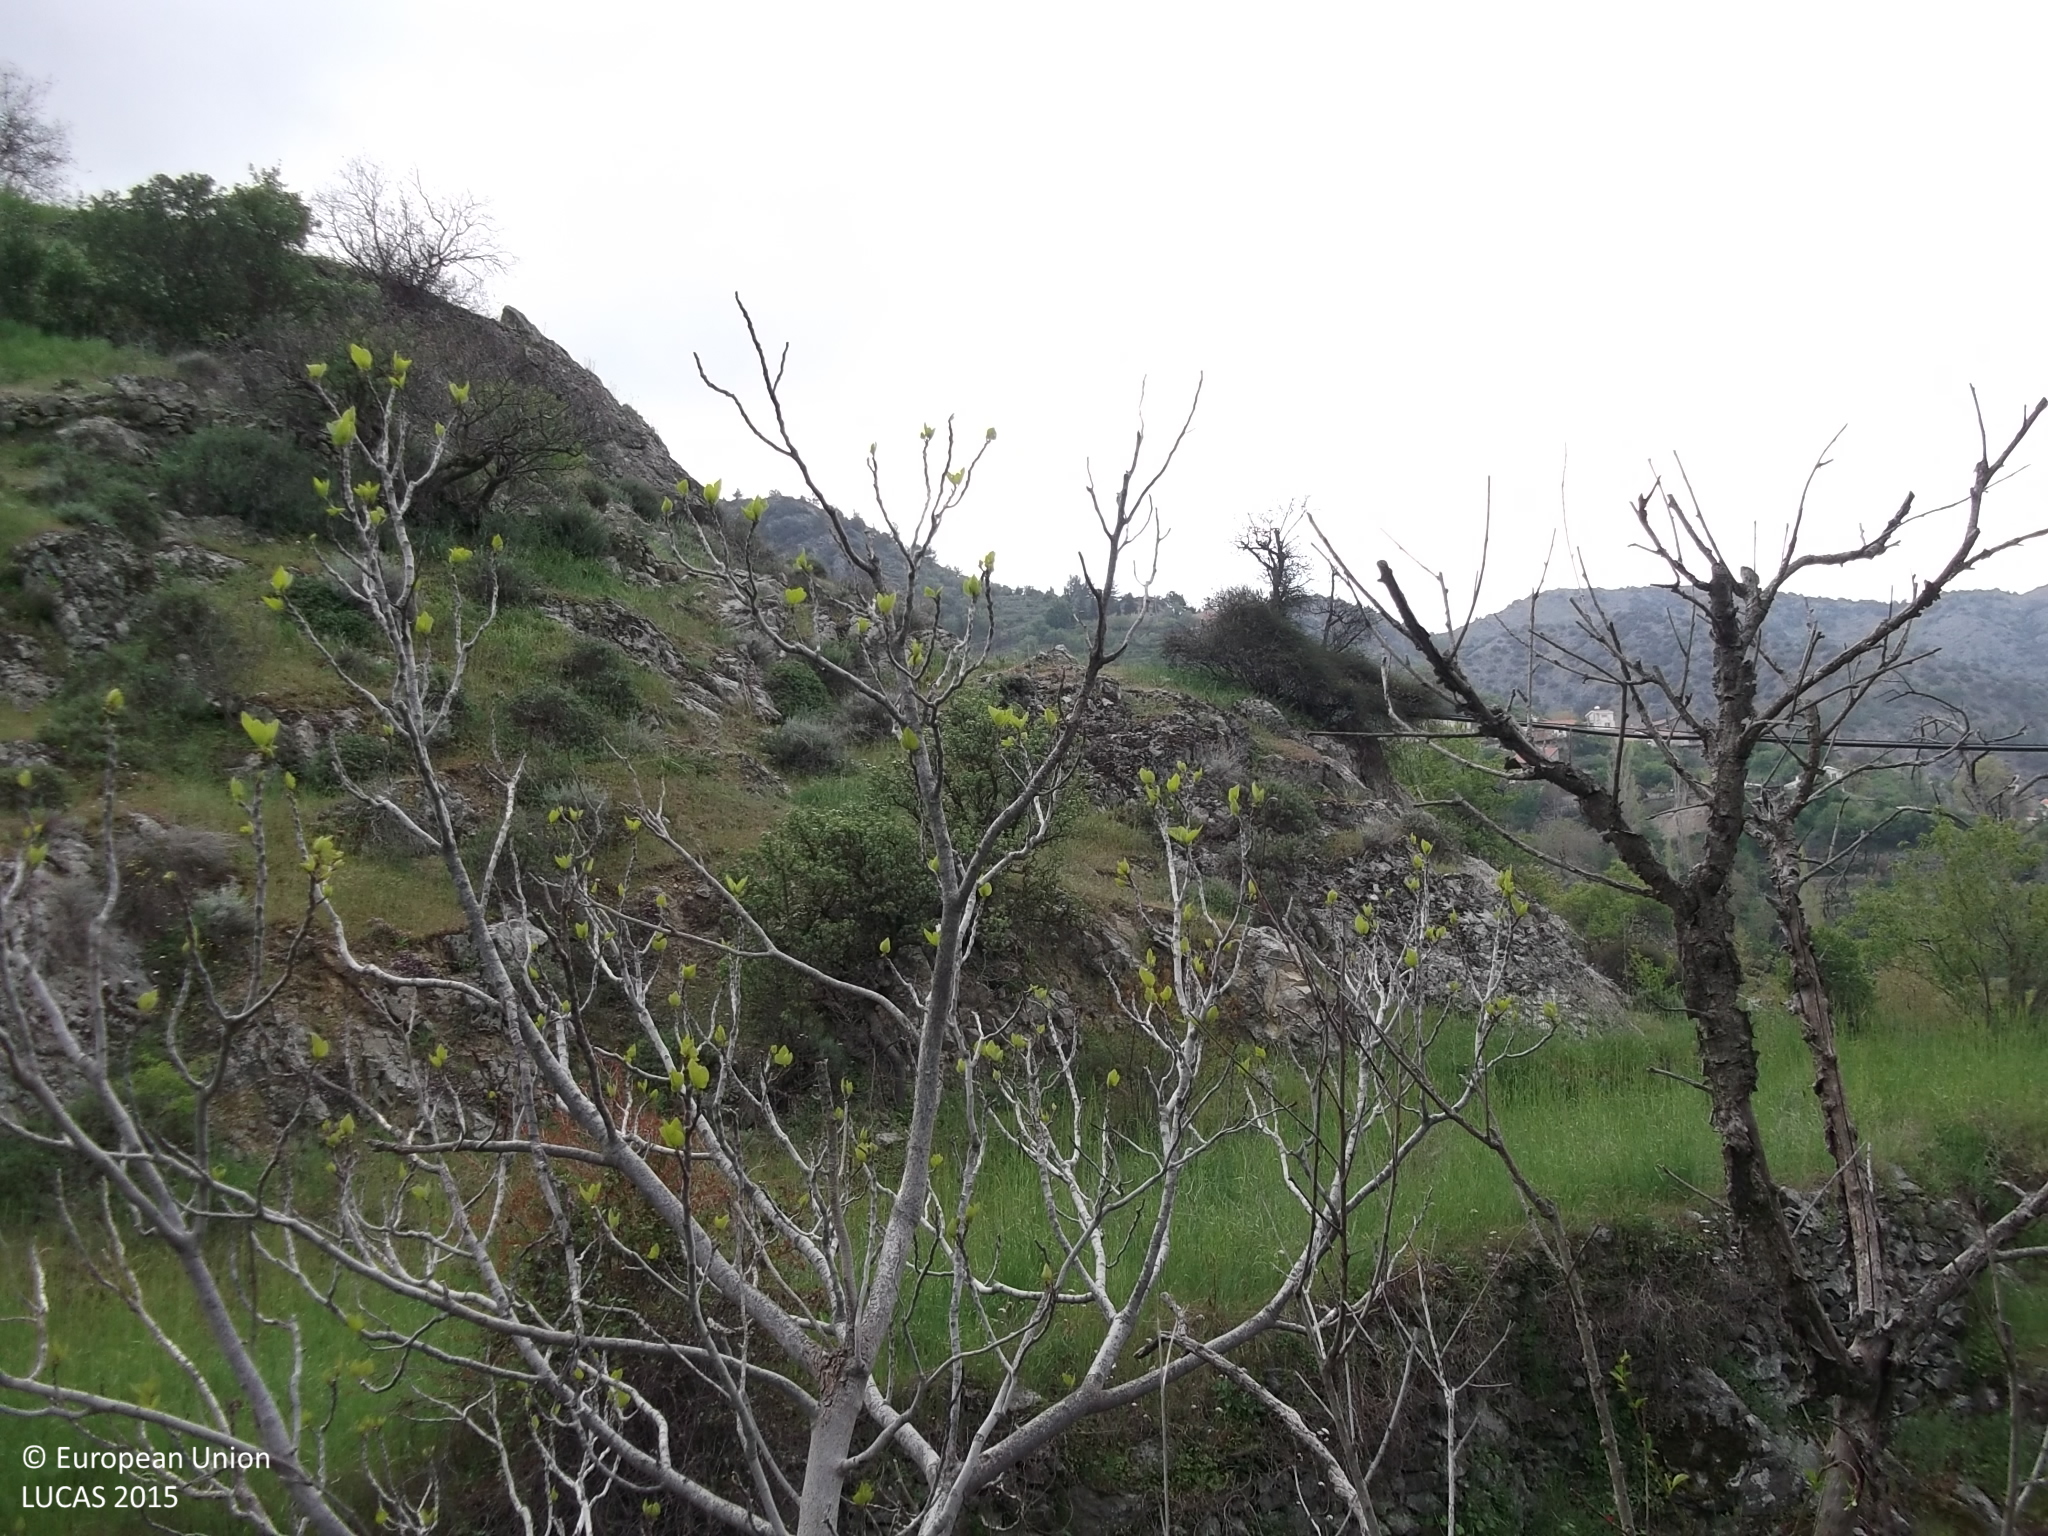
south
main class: Cropland
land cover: Other fruit trees and berries
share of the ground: 10 - 25 %
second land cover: Grassland without tree/shrub cover
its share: > 75 %
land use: Agriculture (excluding fallow land and kitchen gardens)
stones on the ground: 25 - 50 %
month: April
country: CY
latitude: 34.8983
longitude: 33.0321
